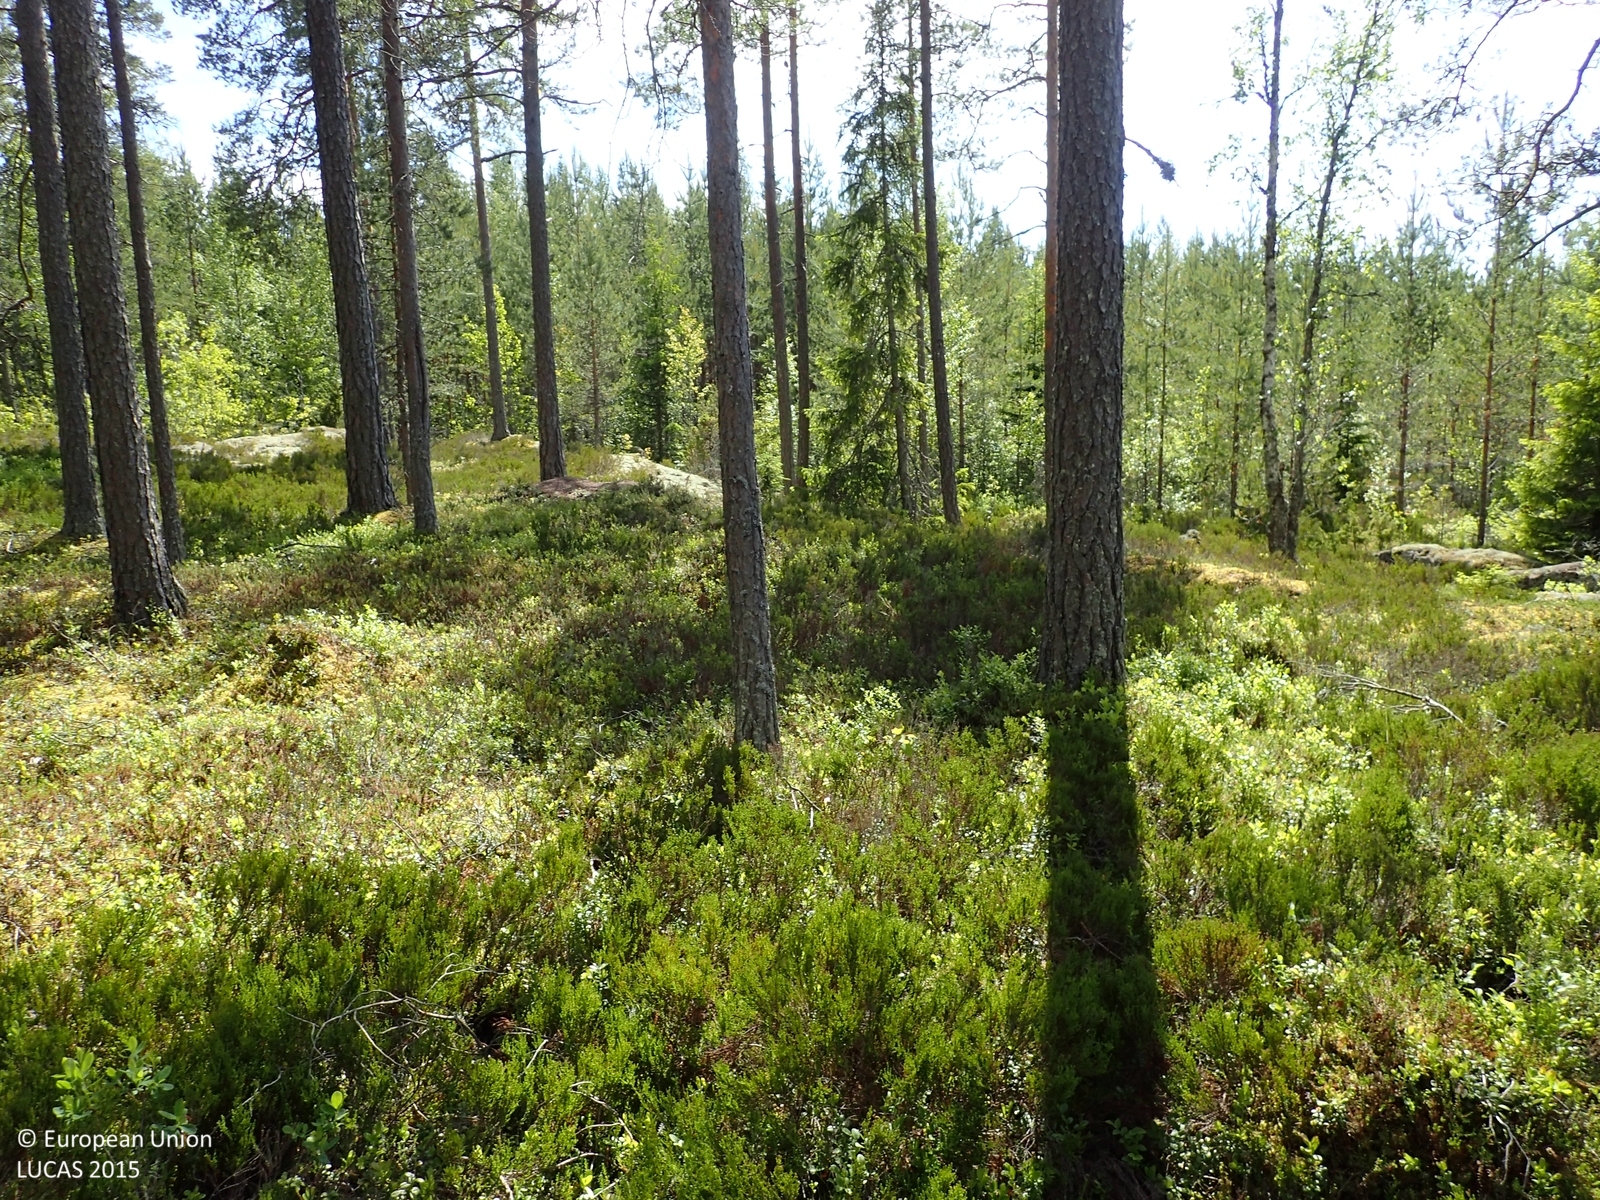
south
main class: Woodland
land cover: Pine dominated coniferous woodland
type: boreal forest
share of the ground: 25 - 50 %
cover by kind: shrubs 50 %, coniferous forest trees 40 %, broadleaved forest trees 5 %, lichens and mosses 5 %
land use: Forestry
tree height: > 5 m
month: June
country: FI
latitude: 62.4327
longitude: 21.6475
